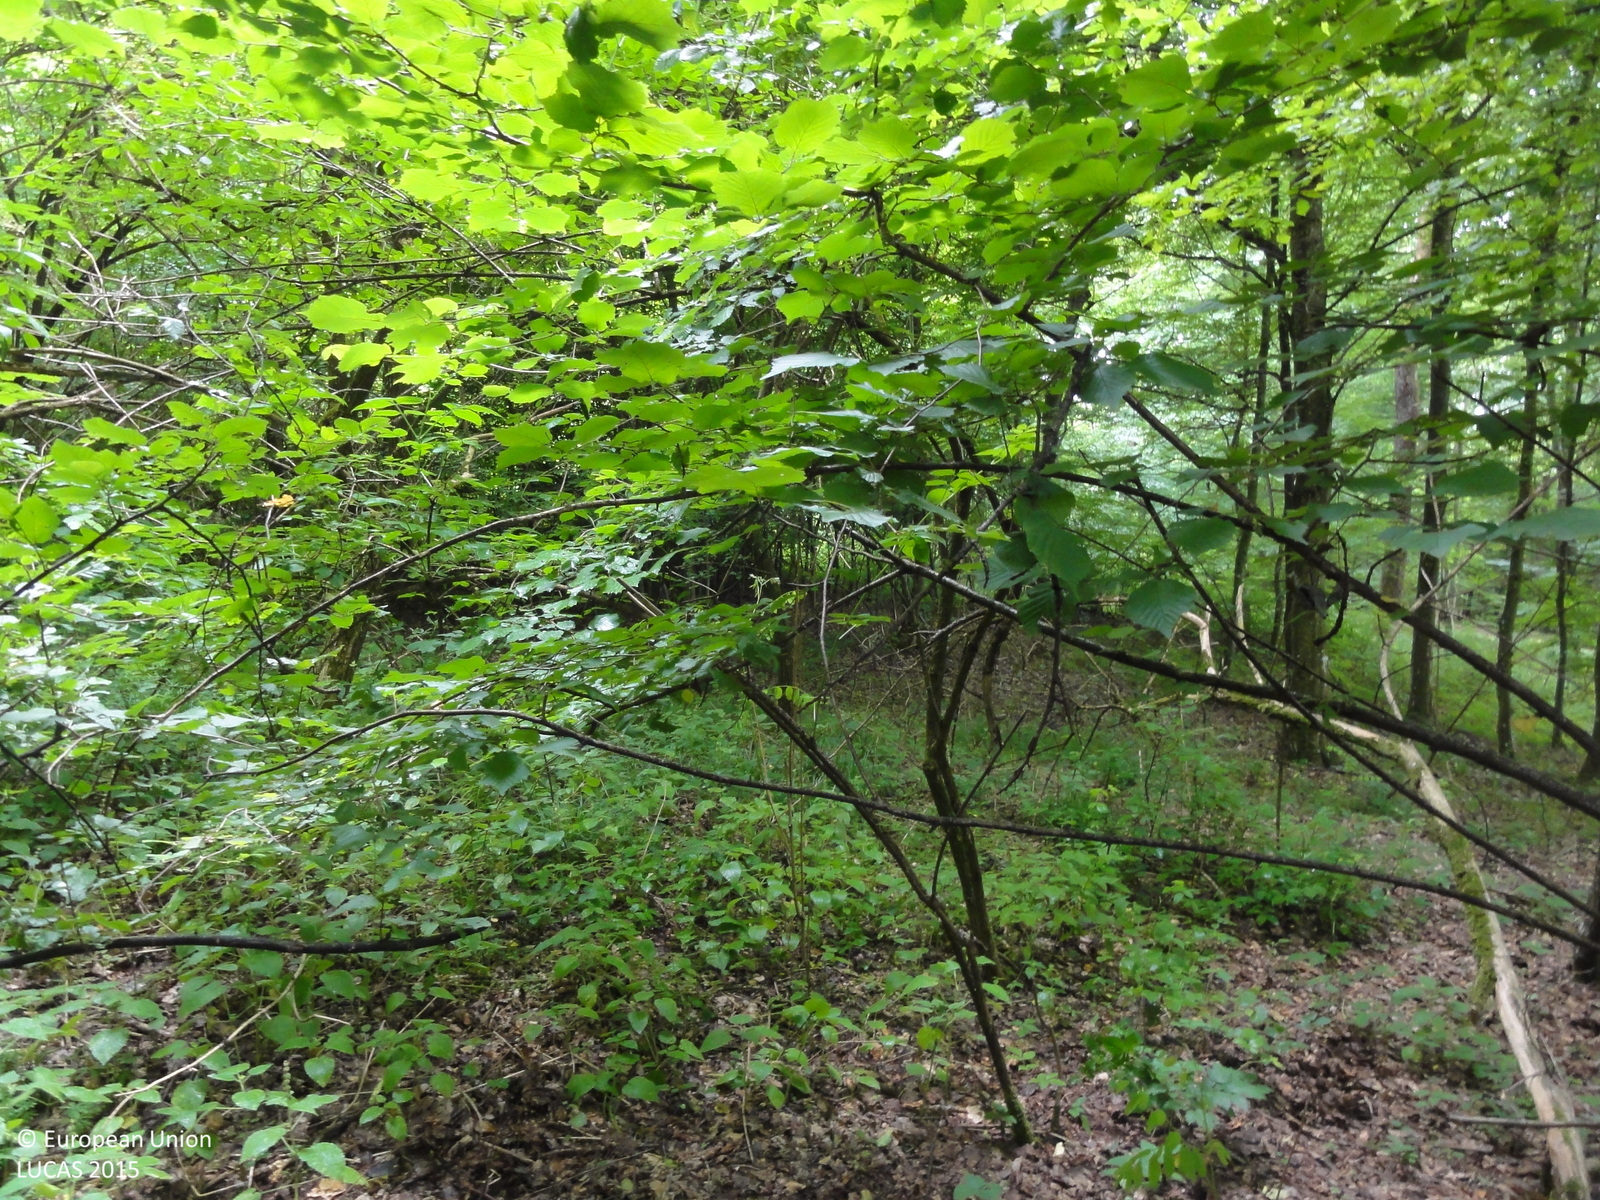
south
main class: Woodland
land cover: Broadleaved woodland
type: mesophytic deciduous forest
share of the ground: > 75 %
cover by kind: broadleaved forest trees 100 %
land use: Forestry
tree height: > 5 m
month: June
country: SI
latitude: 46.7317
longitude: 16.1905
